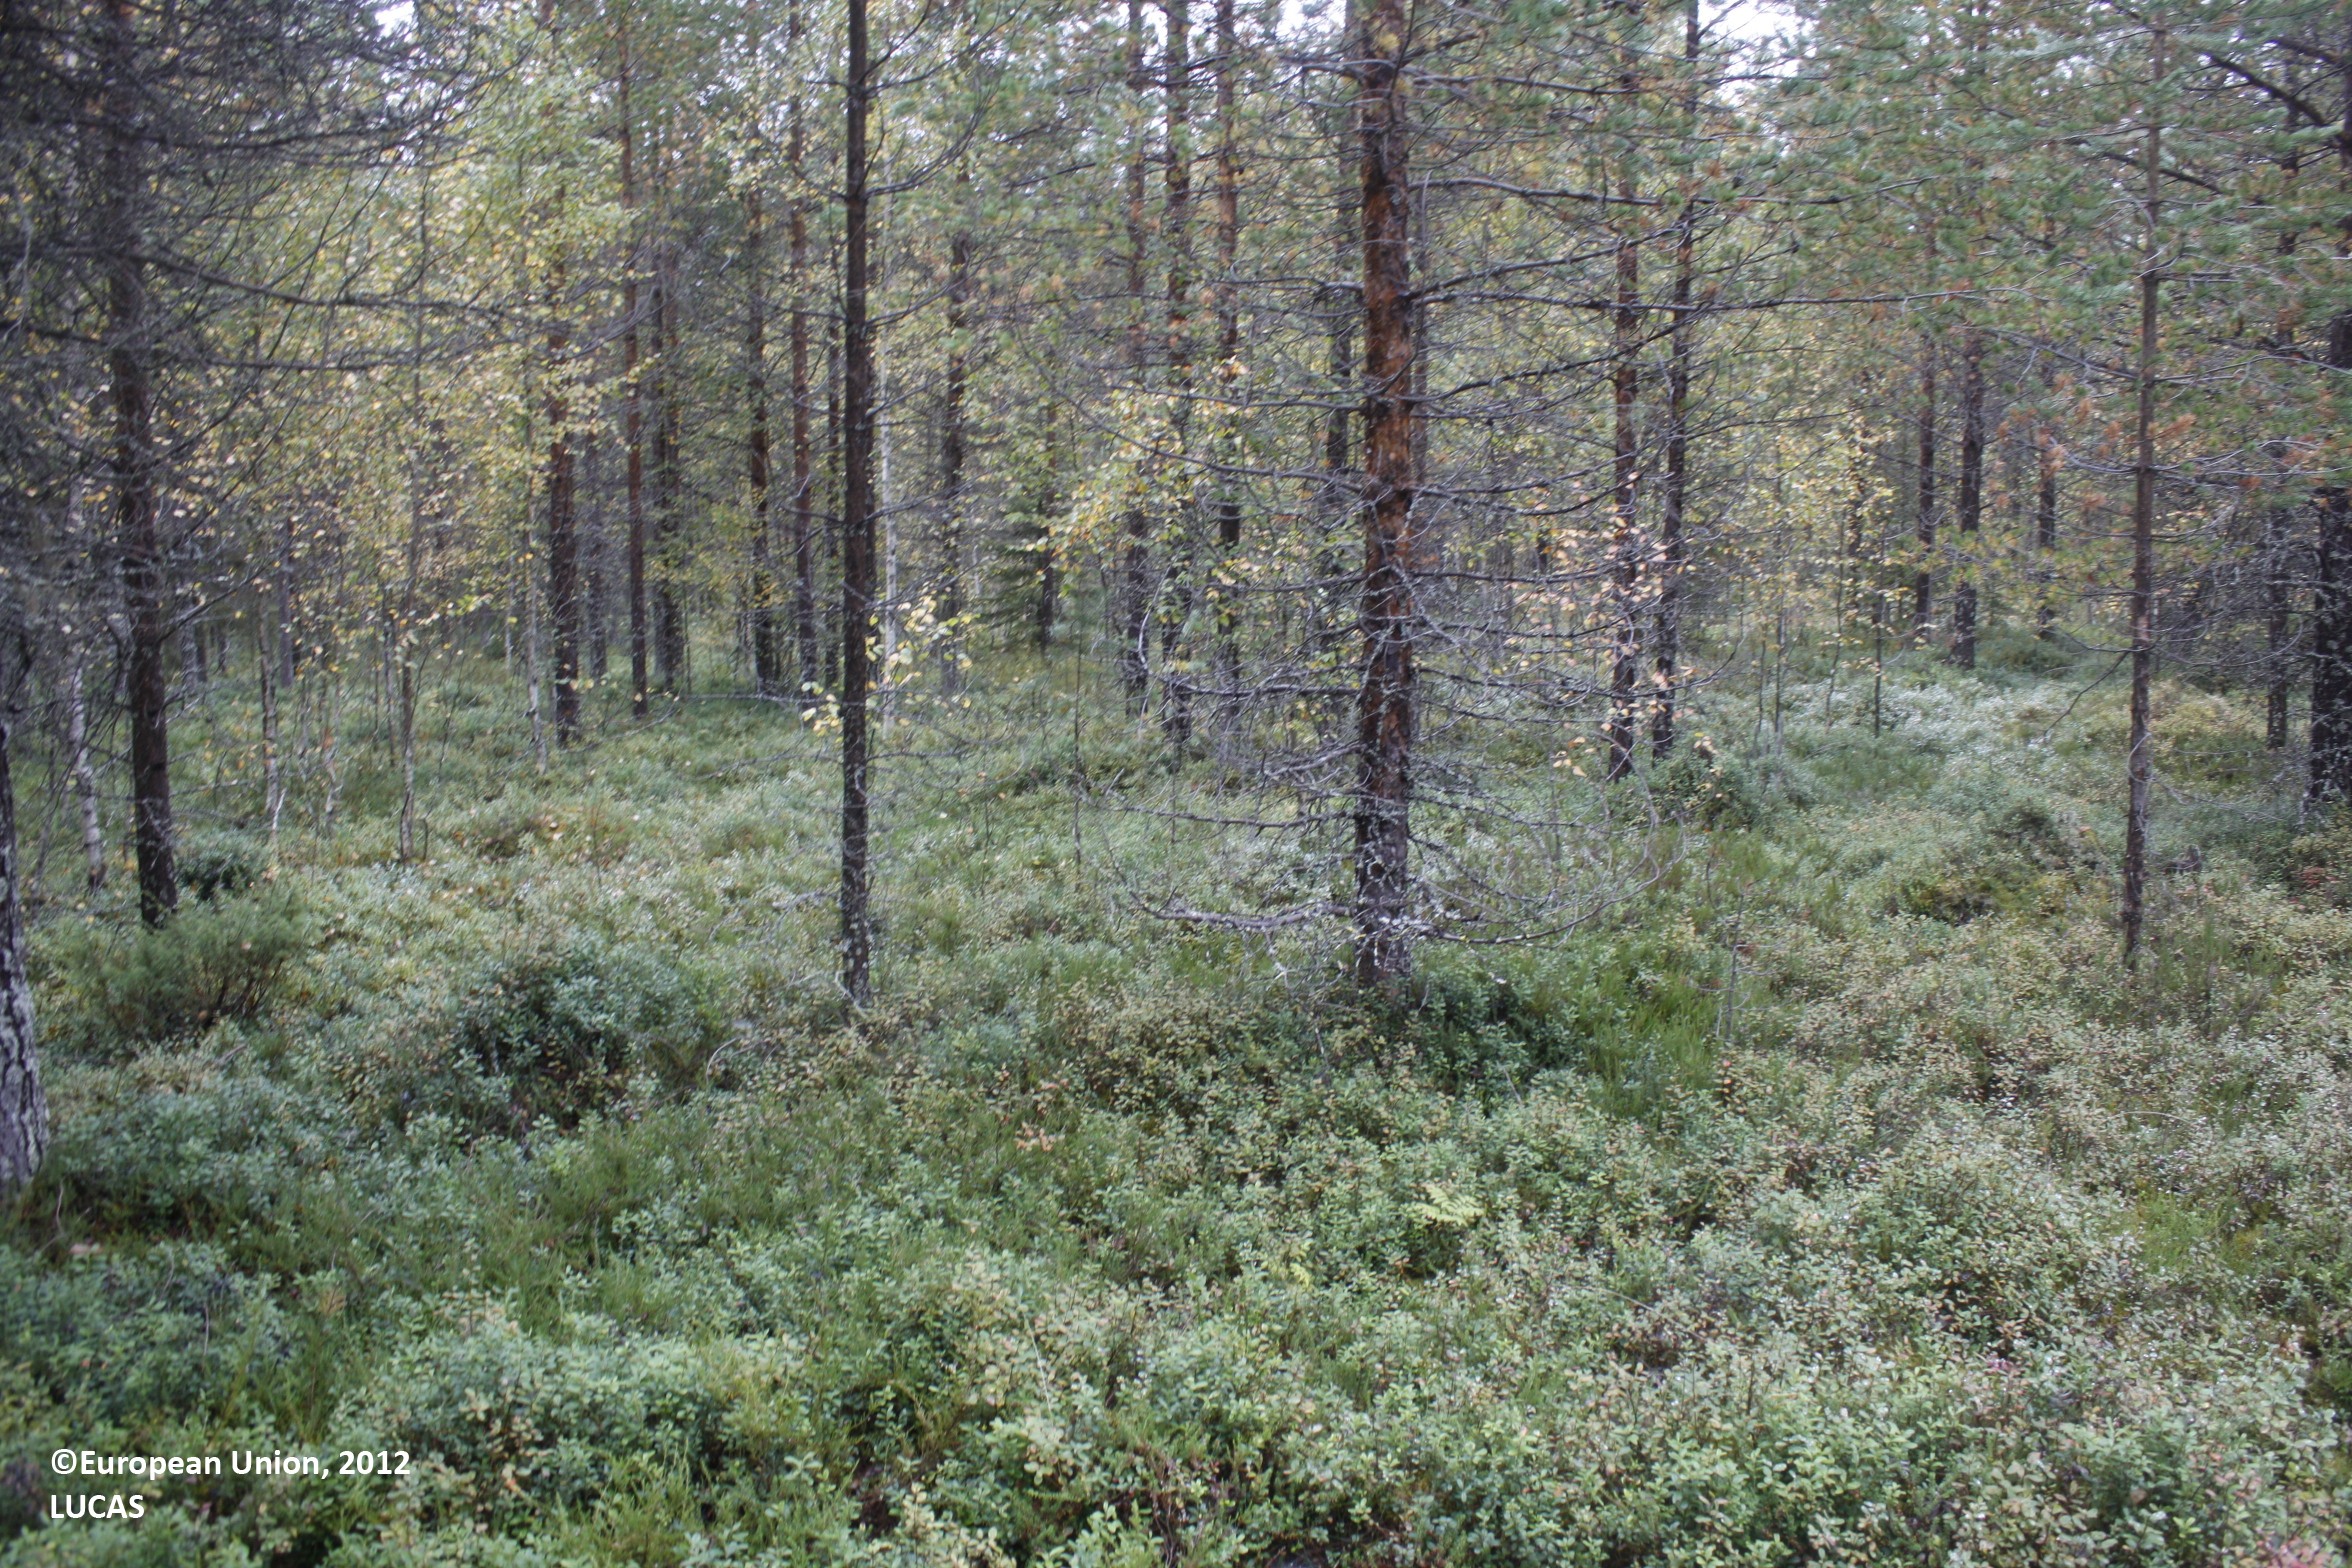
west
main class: Woodland
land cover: Pine dominated mixed woodland
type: boreal forest
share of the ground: 50 - 75 %
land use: Forestry
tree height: > 5 m
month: September
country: FI
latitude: 65.1747
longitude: 26.6969
